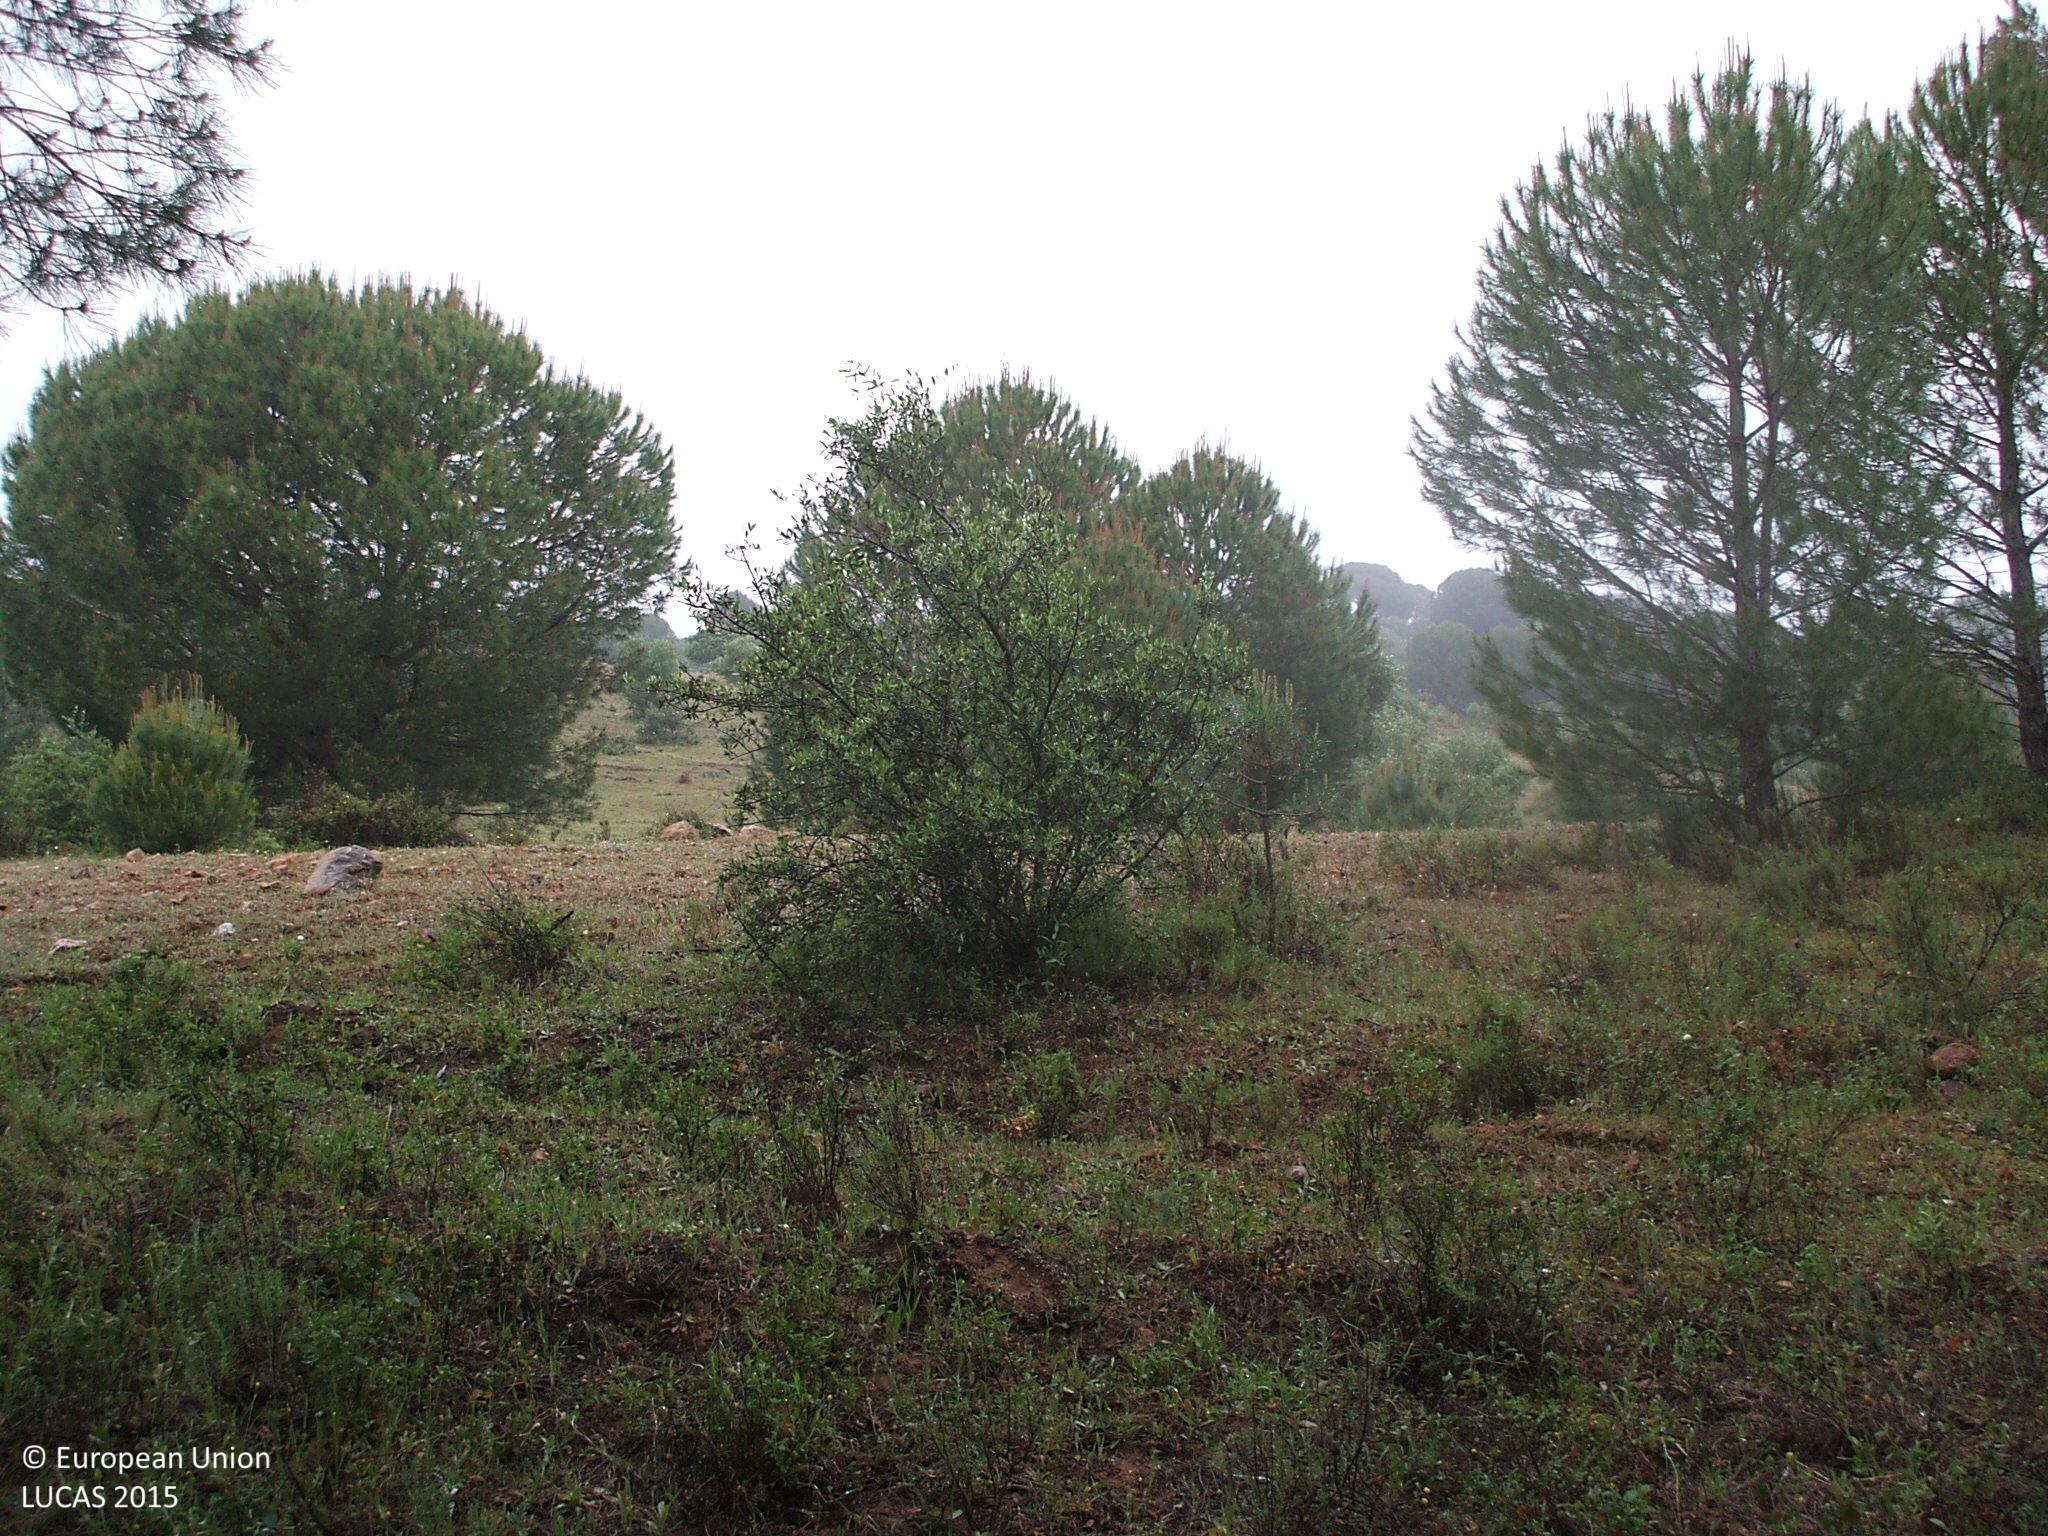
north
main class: Woodland
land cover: Pine dominated coniferous woodland
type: coniferous forest of the mediterranean region
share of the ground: 50 - 75 %
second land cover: Shrubland without tree cover
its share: 10 - 25 %
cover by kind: coniferous forest trees 60 %, shrubs 20 %, herbaceous plants 20 %
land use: Forestry
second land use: Agriculture (excluding fallow land and kitchen gardens)
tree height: > 5 m
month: April
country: ES
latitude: 37.7085
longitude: -5.5744
